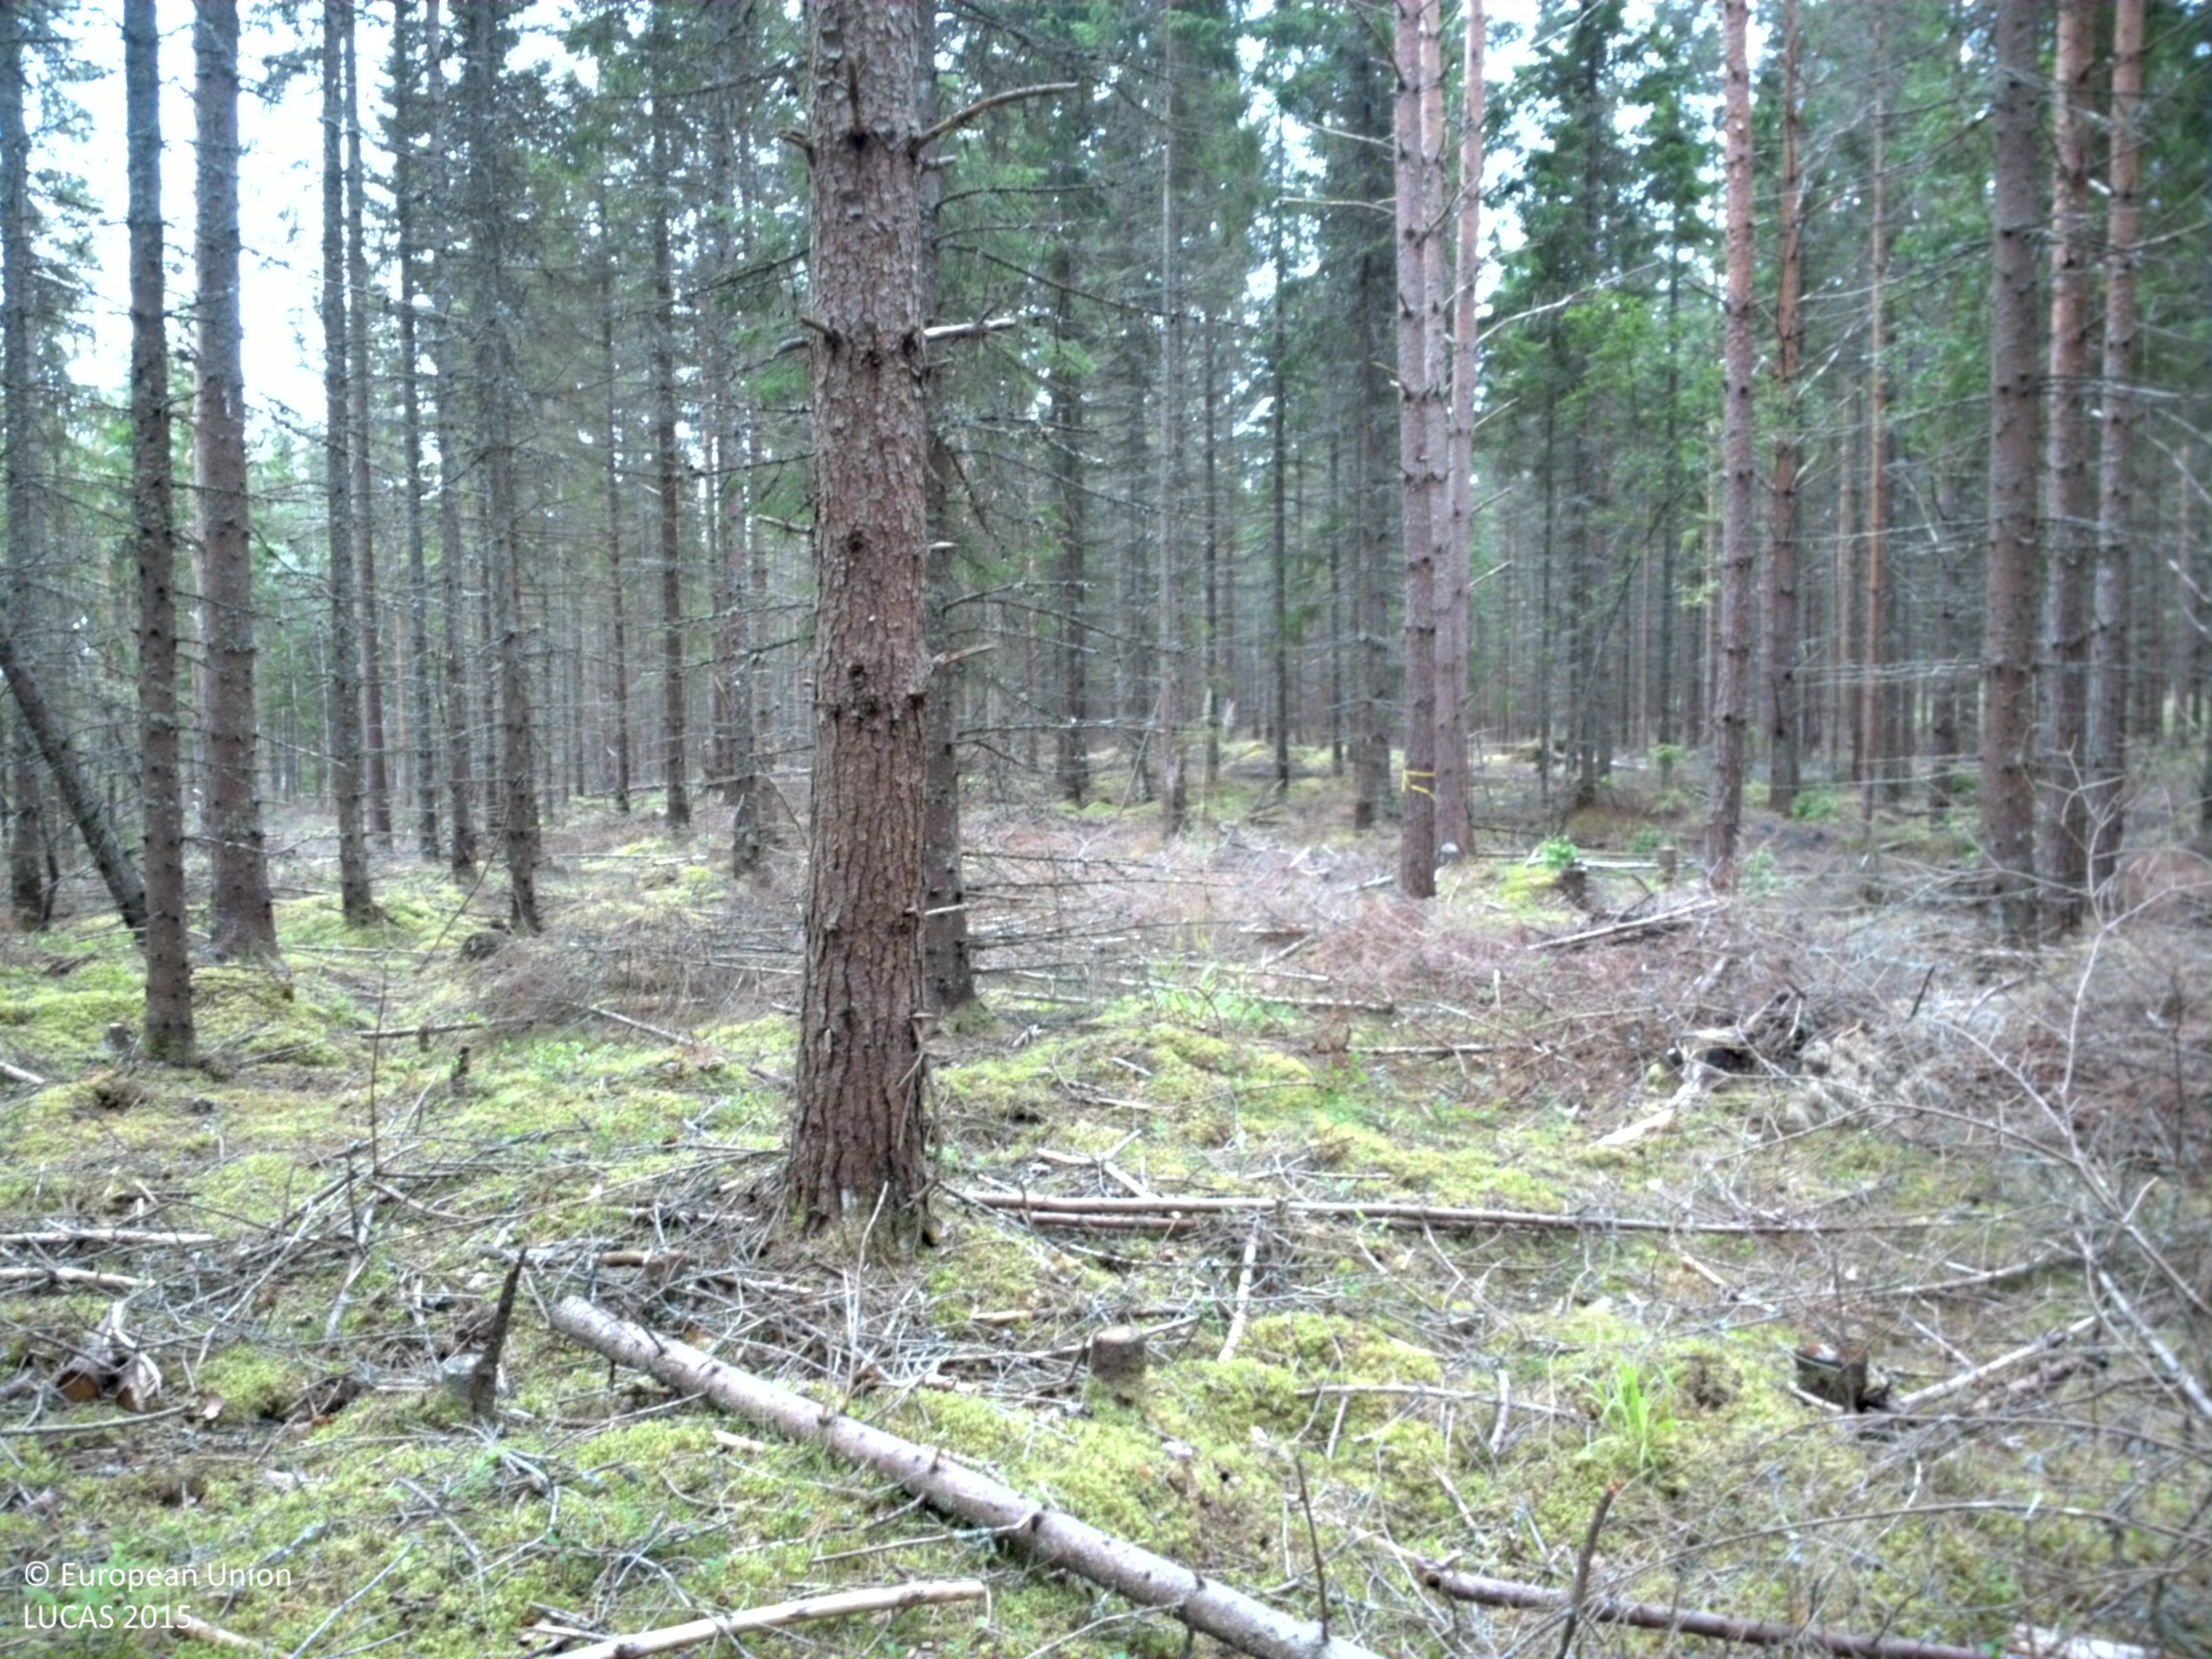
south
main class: Woodland
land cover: Spruce dominated coniferous woodland
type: boreal forest
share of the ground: 25 - 50 %
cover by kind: lichens and mosses 50 %, coniferous forest trees 45 %, herbaceous plants 5 %
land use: Forestry
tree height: > 5 m
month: July
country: SE
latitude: 58.9171
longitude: 14.5596
